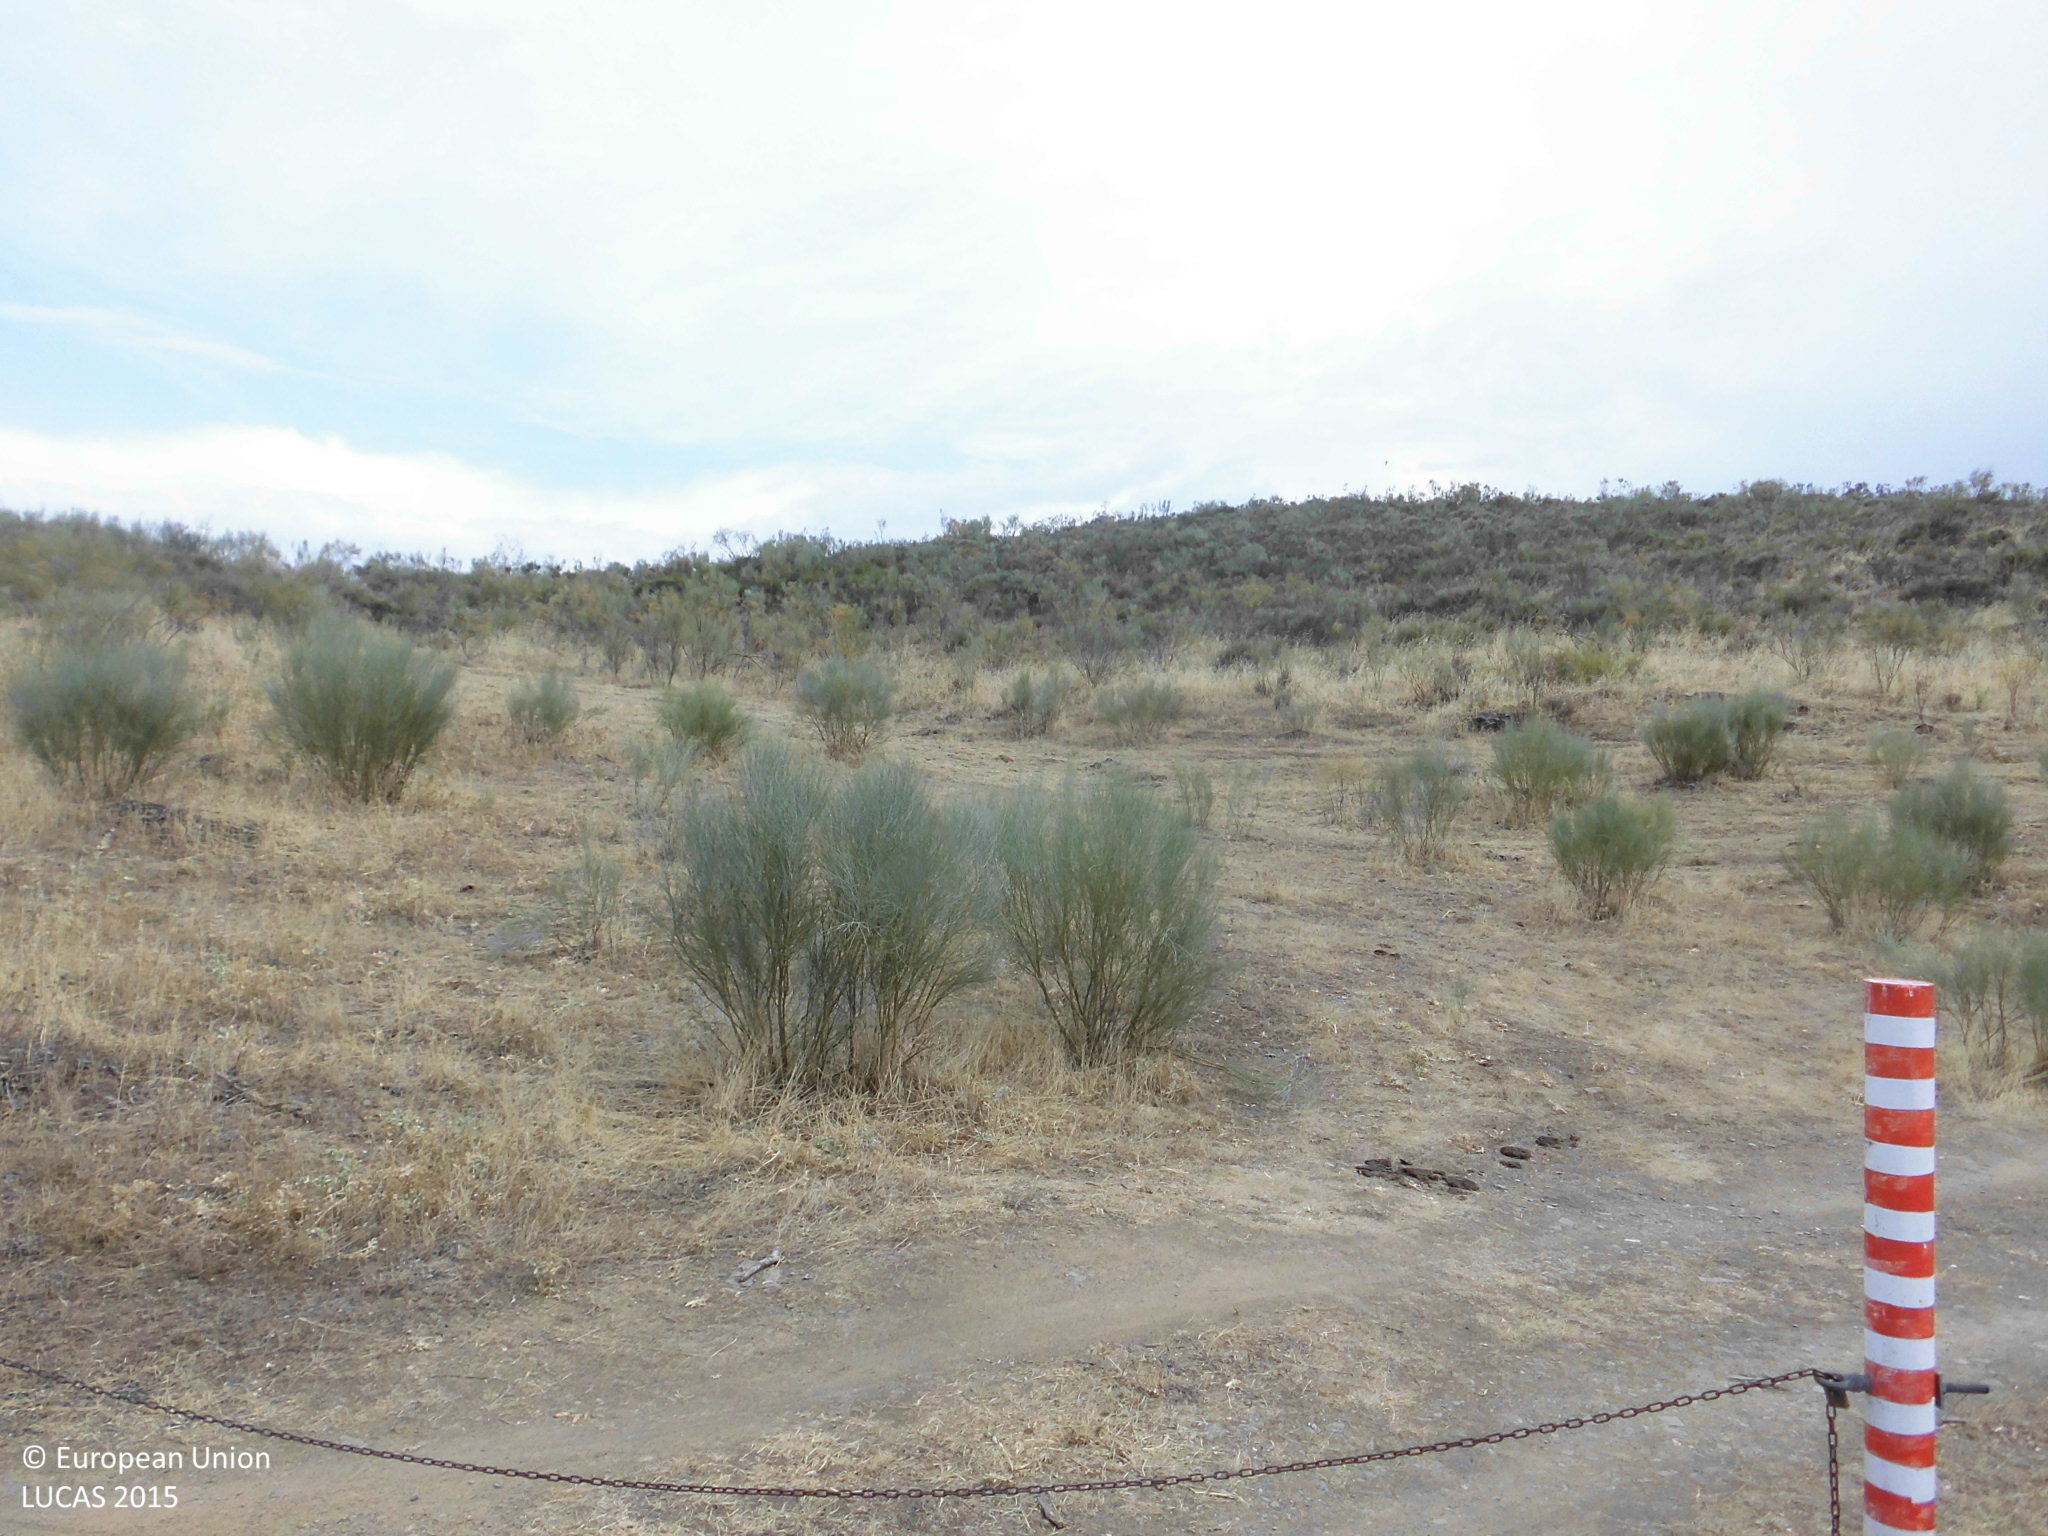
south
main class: Shrubland
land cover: Shrubland without tree cover
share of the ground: 25 - 50 %
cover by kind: shrubs 50 %, herbaceous plants 50 %
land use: Agriculture (excluding fallow land and kitchen gardens)
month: July
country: ES
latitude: 39.7581
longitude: -5.6410
